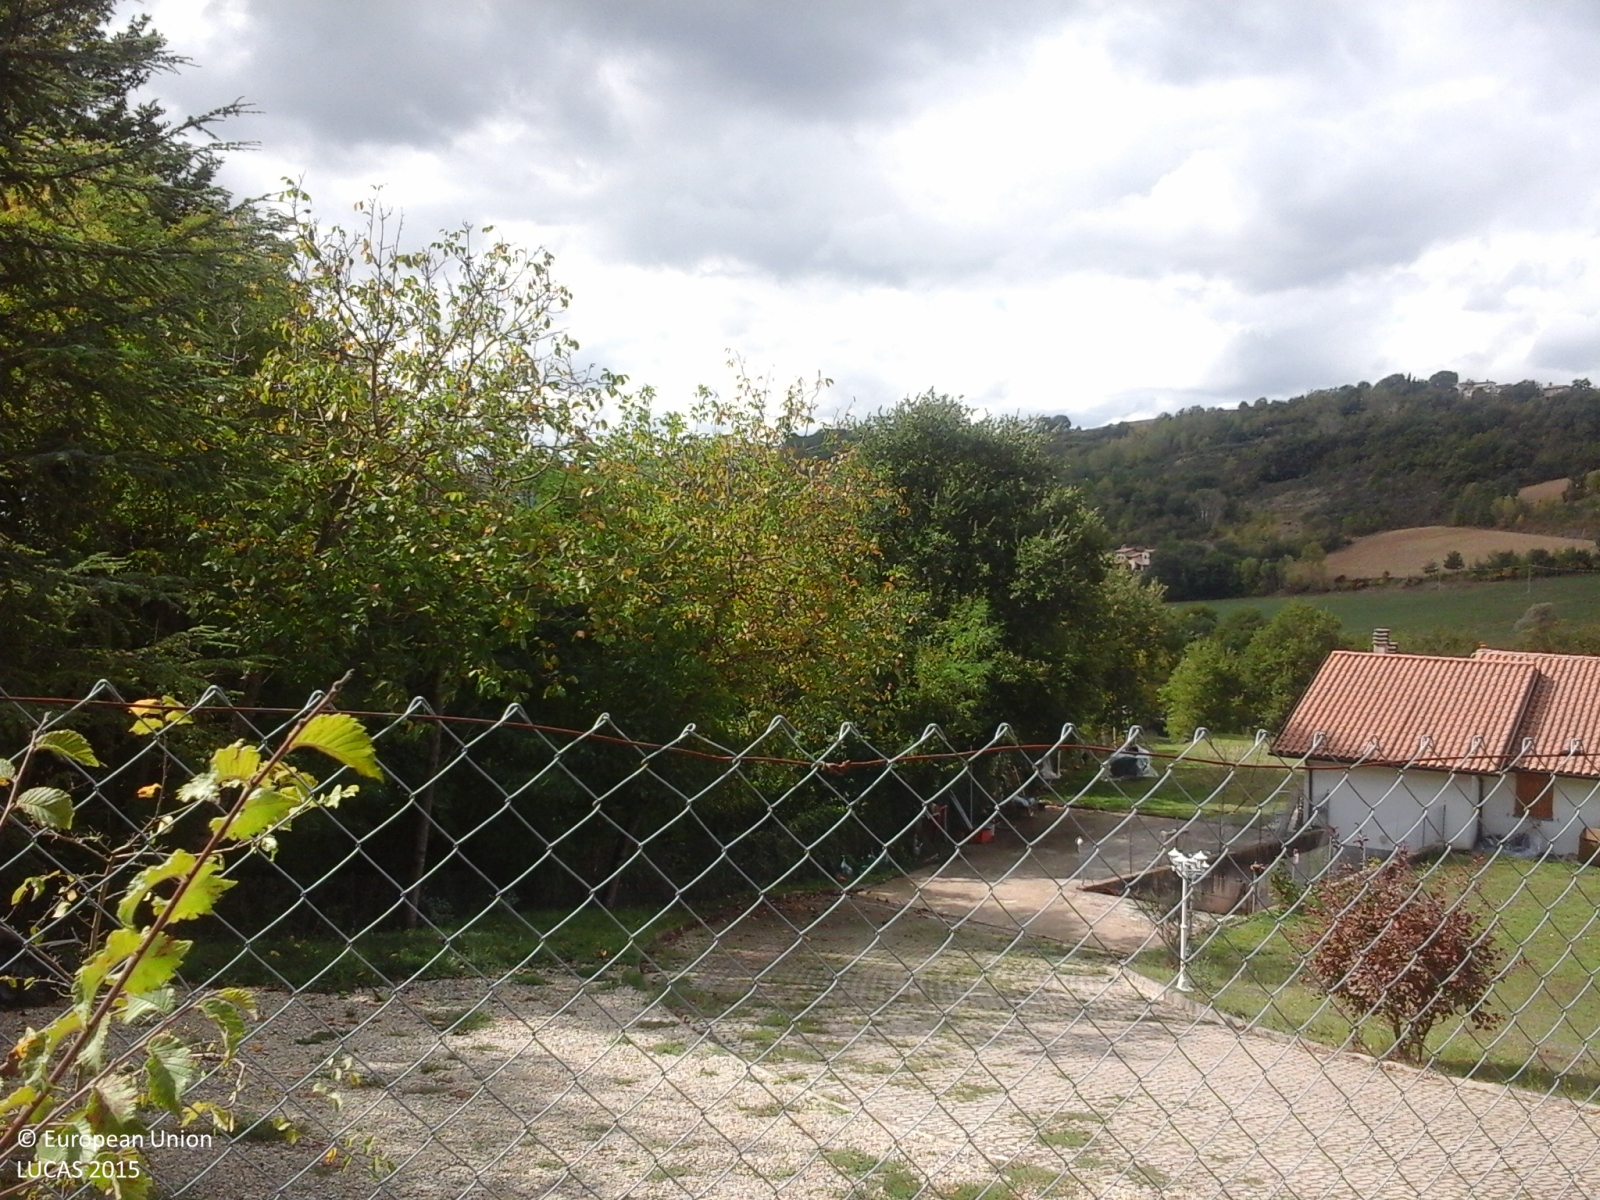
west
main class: Woodland
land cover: Broadleaved woodland
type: thermophilous deciduous forest
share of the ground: > 75 %
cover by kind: broadleaved forest trees 100 %
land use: Forestry
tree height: > 5 m
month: October
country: IT
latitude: 43.4411
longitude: 12.2796
